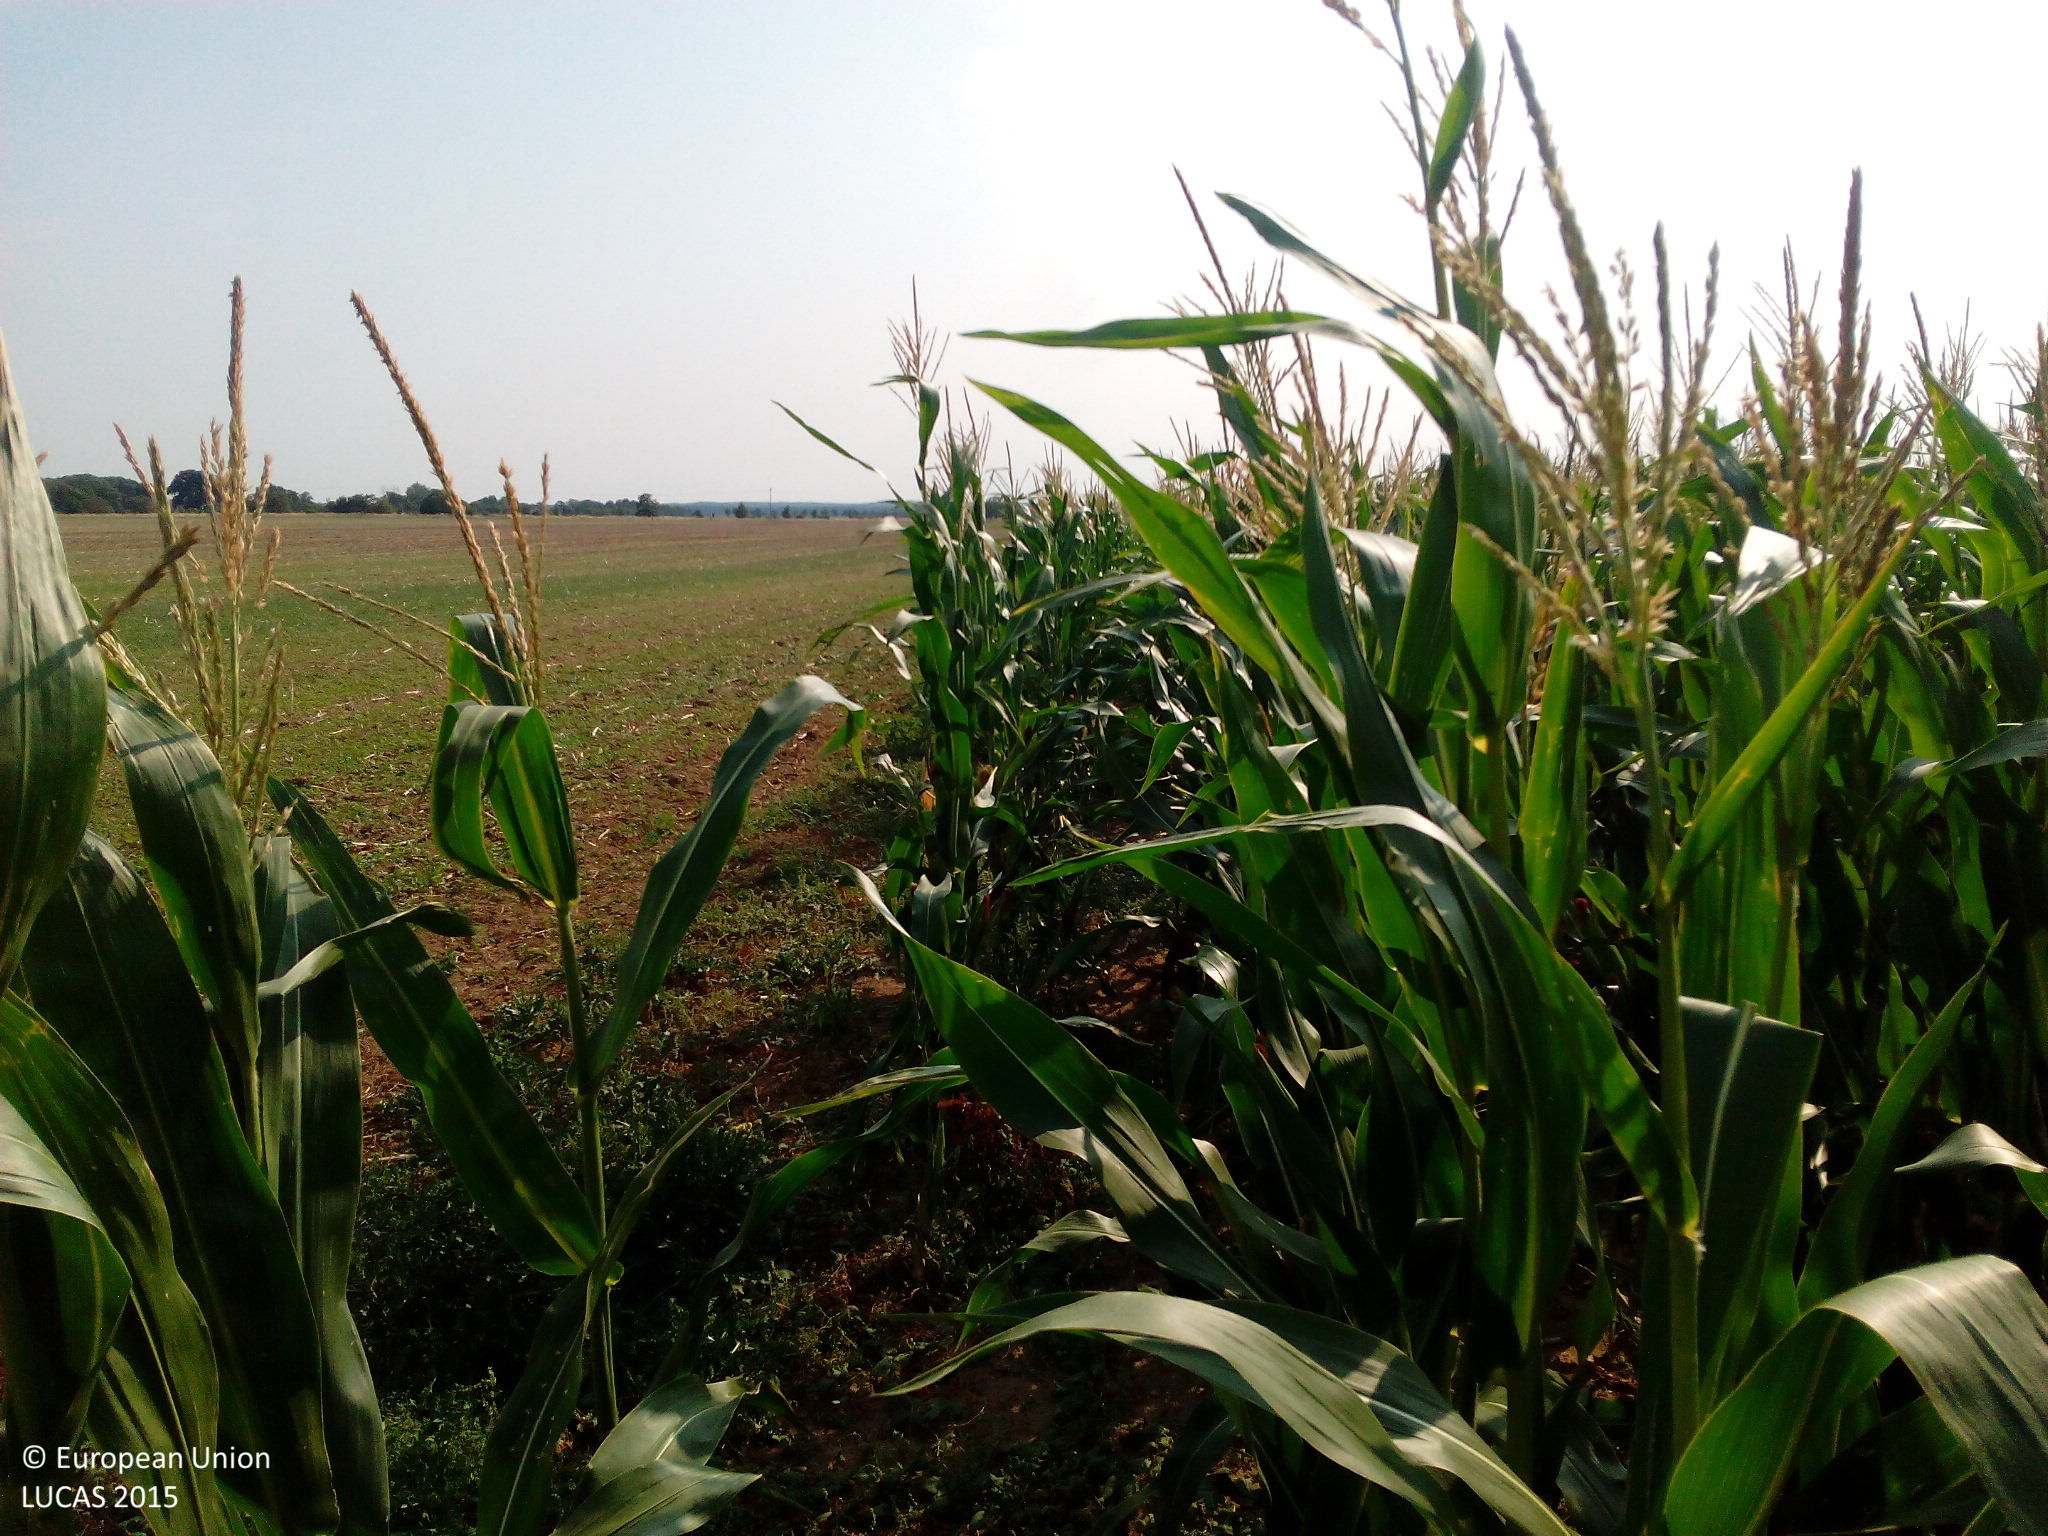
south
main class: Cropland
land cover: Maize
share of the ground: > 75 %
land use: Agriculture (excluding fallow land and kitchen gardens)
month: August
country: DE
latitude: 52.9220
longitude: 11.7397
